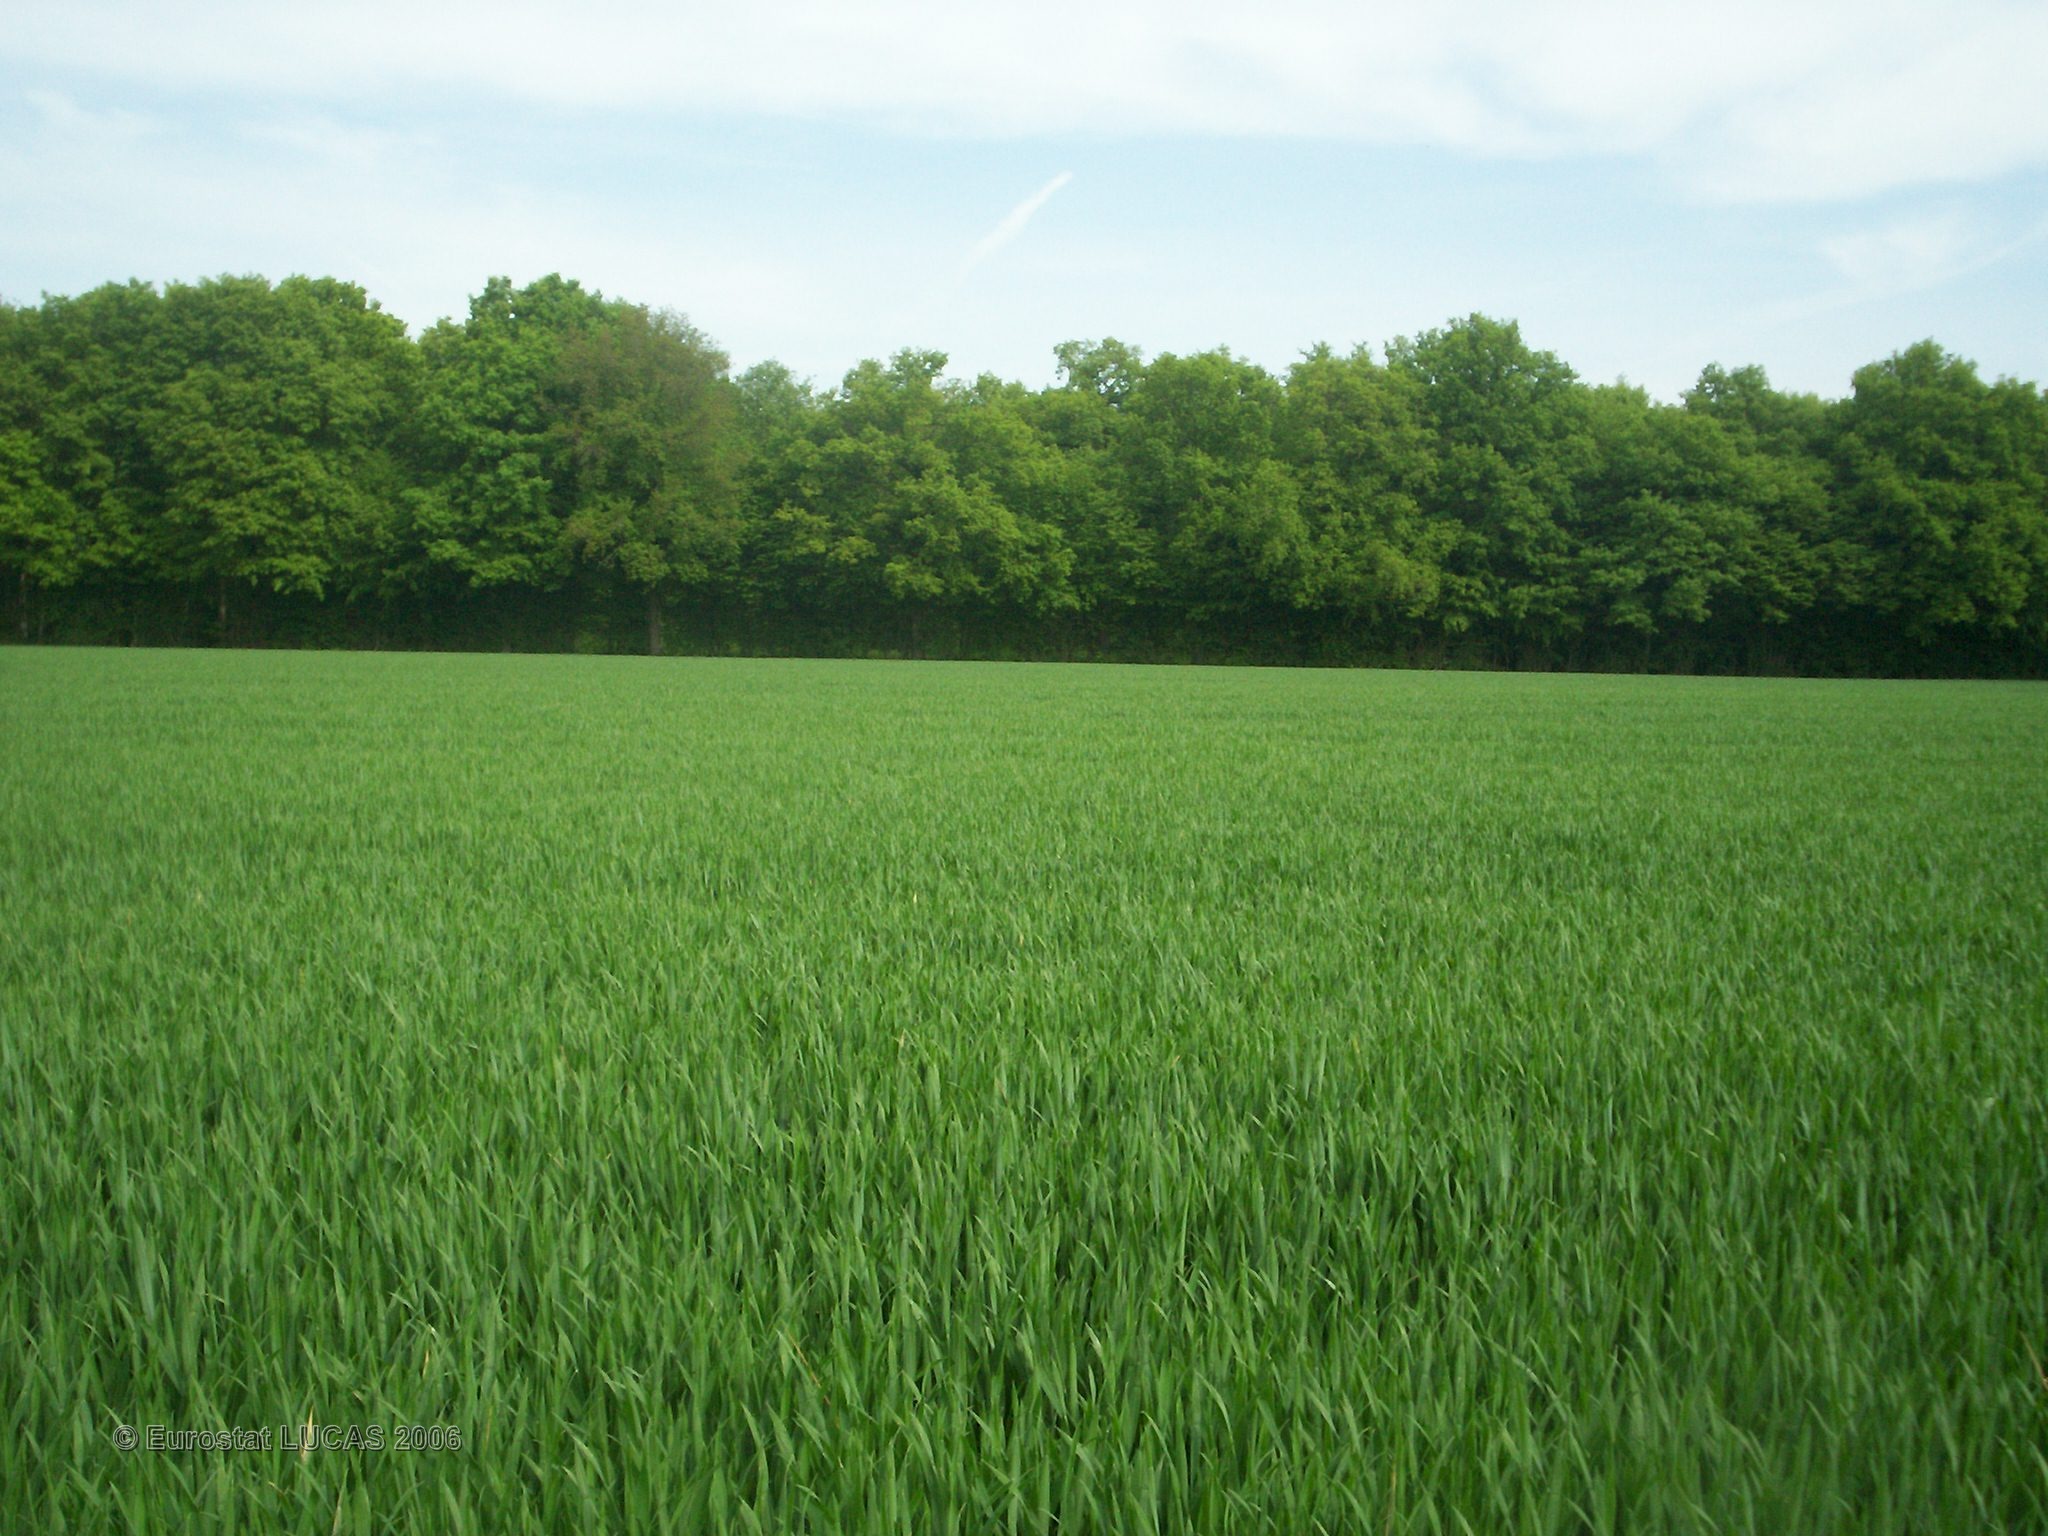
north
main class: Cropland
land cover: Barley
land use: Agriculture (excluding fallow land and kitchen gardens)
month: May
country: FR
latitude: 47.7475
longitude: 2.9912
